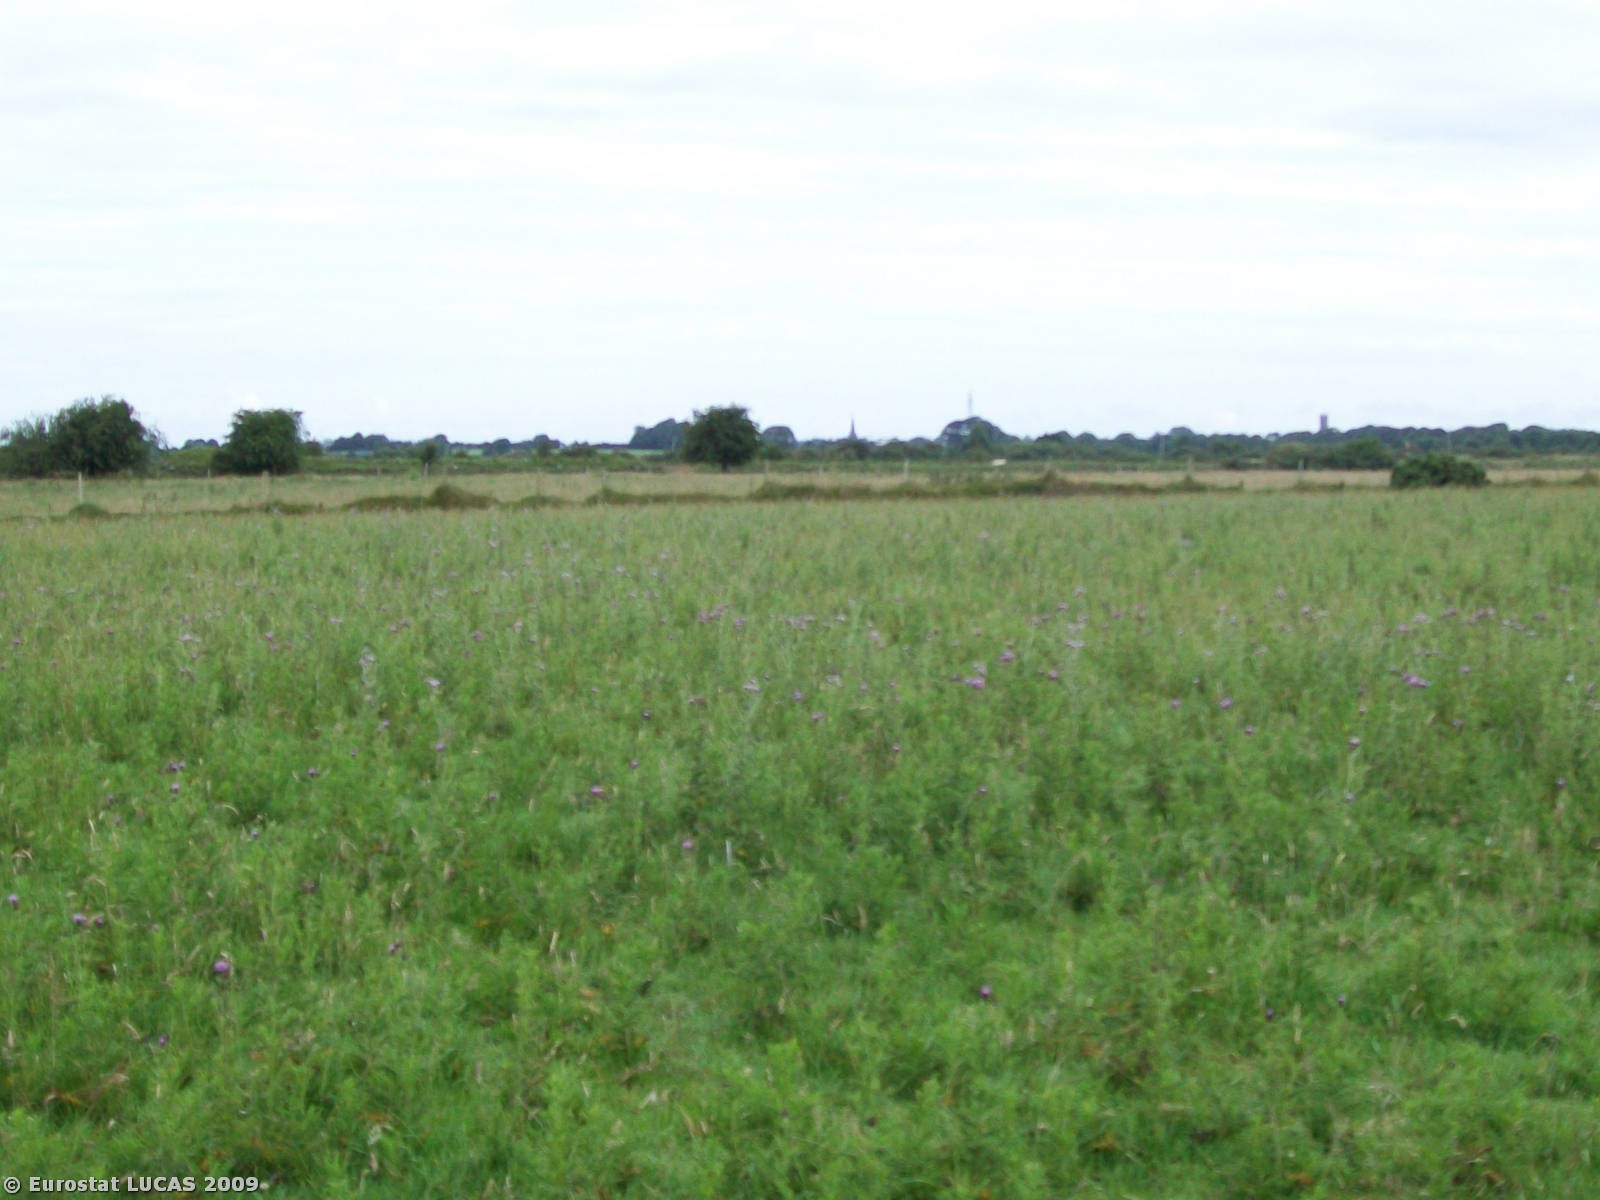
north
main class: Grassland
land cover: Grassland without tree/shrub cover
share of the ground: > 75 %
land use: Agriculture (excluding fallow land and kitchen gardens)
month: July
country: IE
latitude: 53.4920
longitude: -8.8514
